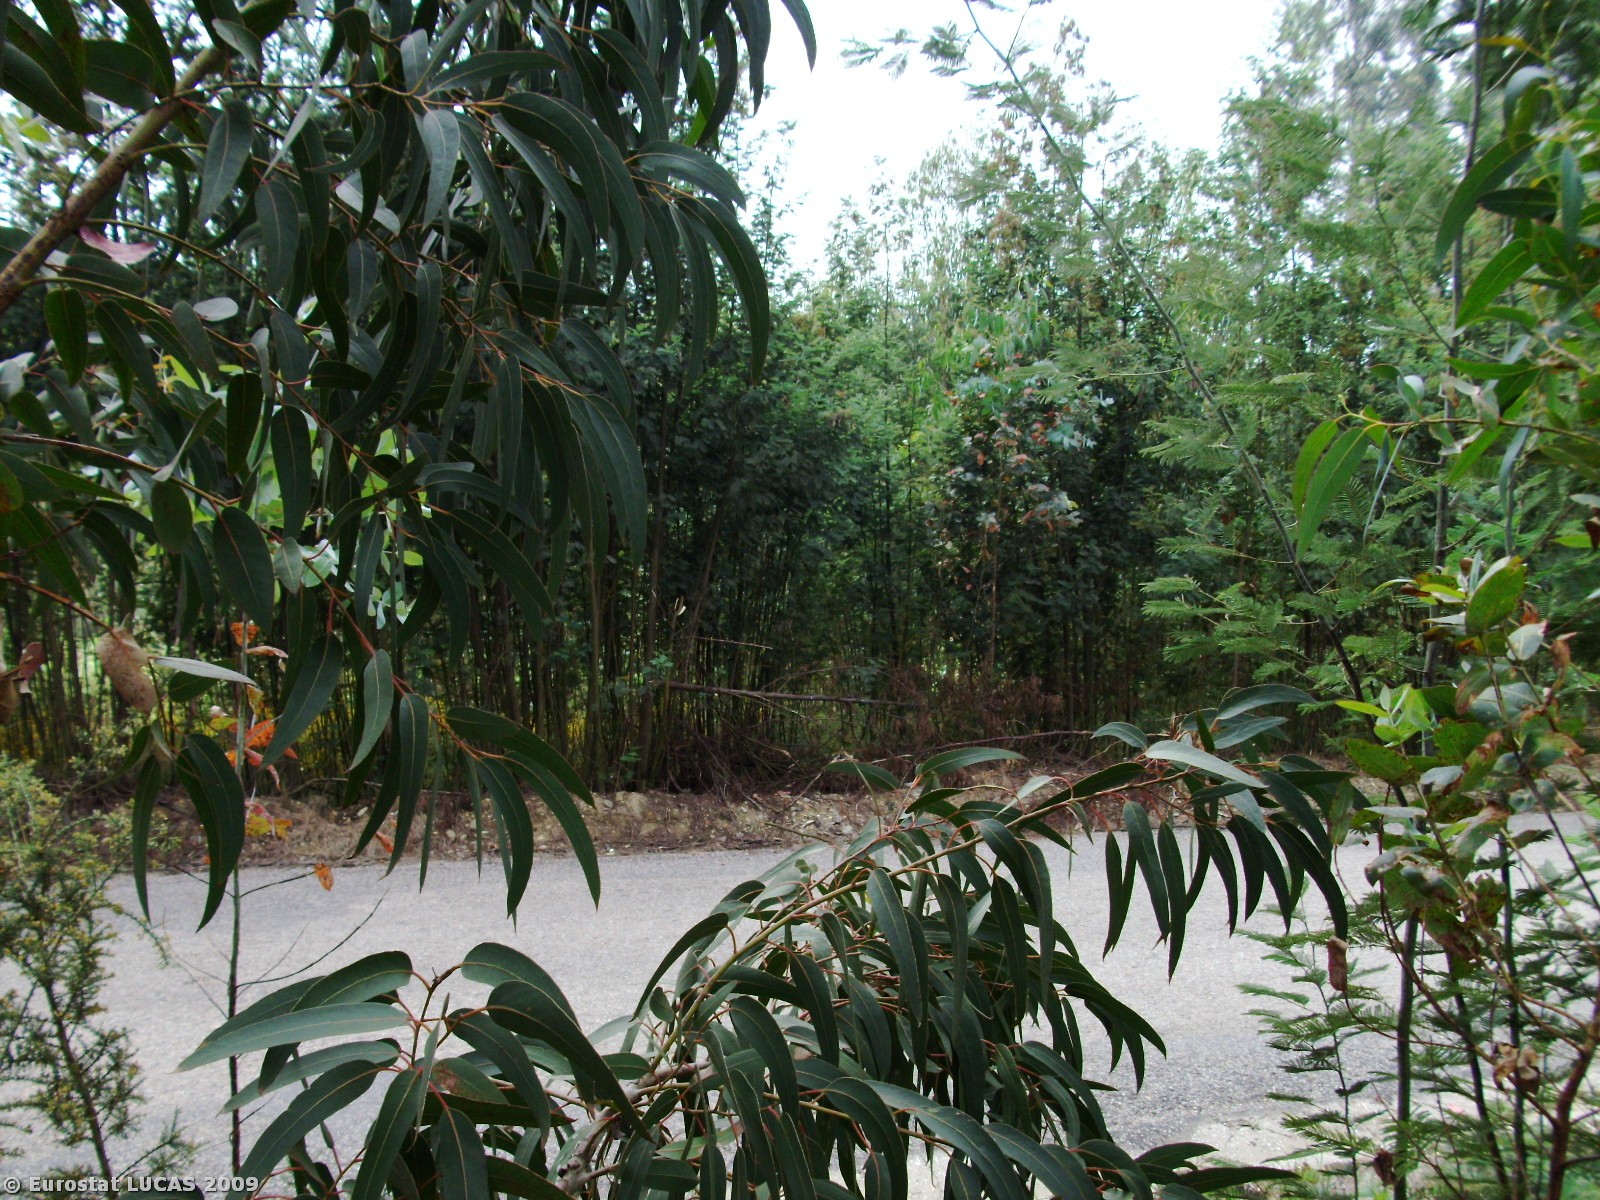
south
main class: Woodland
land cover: Broadleaved woodland
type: plantations and self-sown exotic forest
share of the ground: > 75 %
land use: Forestry
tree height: > 5 m
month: May
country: PT
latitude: 40.5134
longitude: -8.3687
